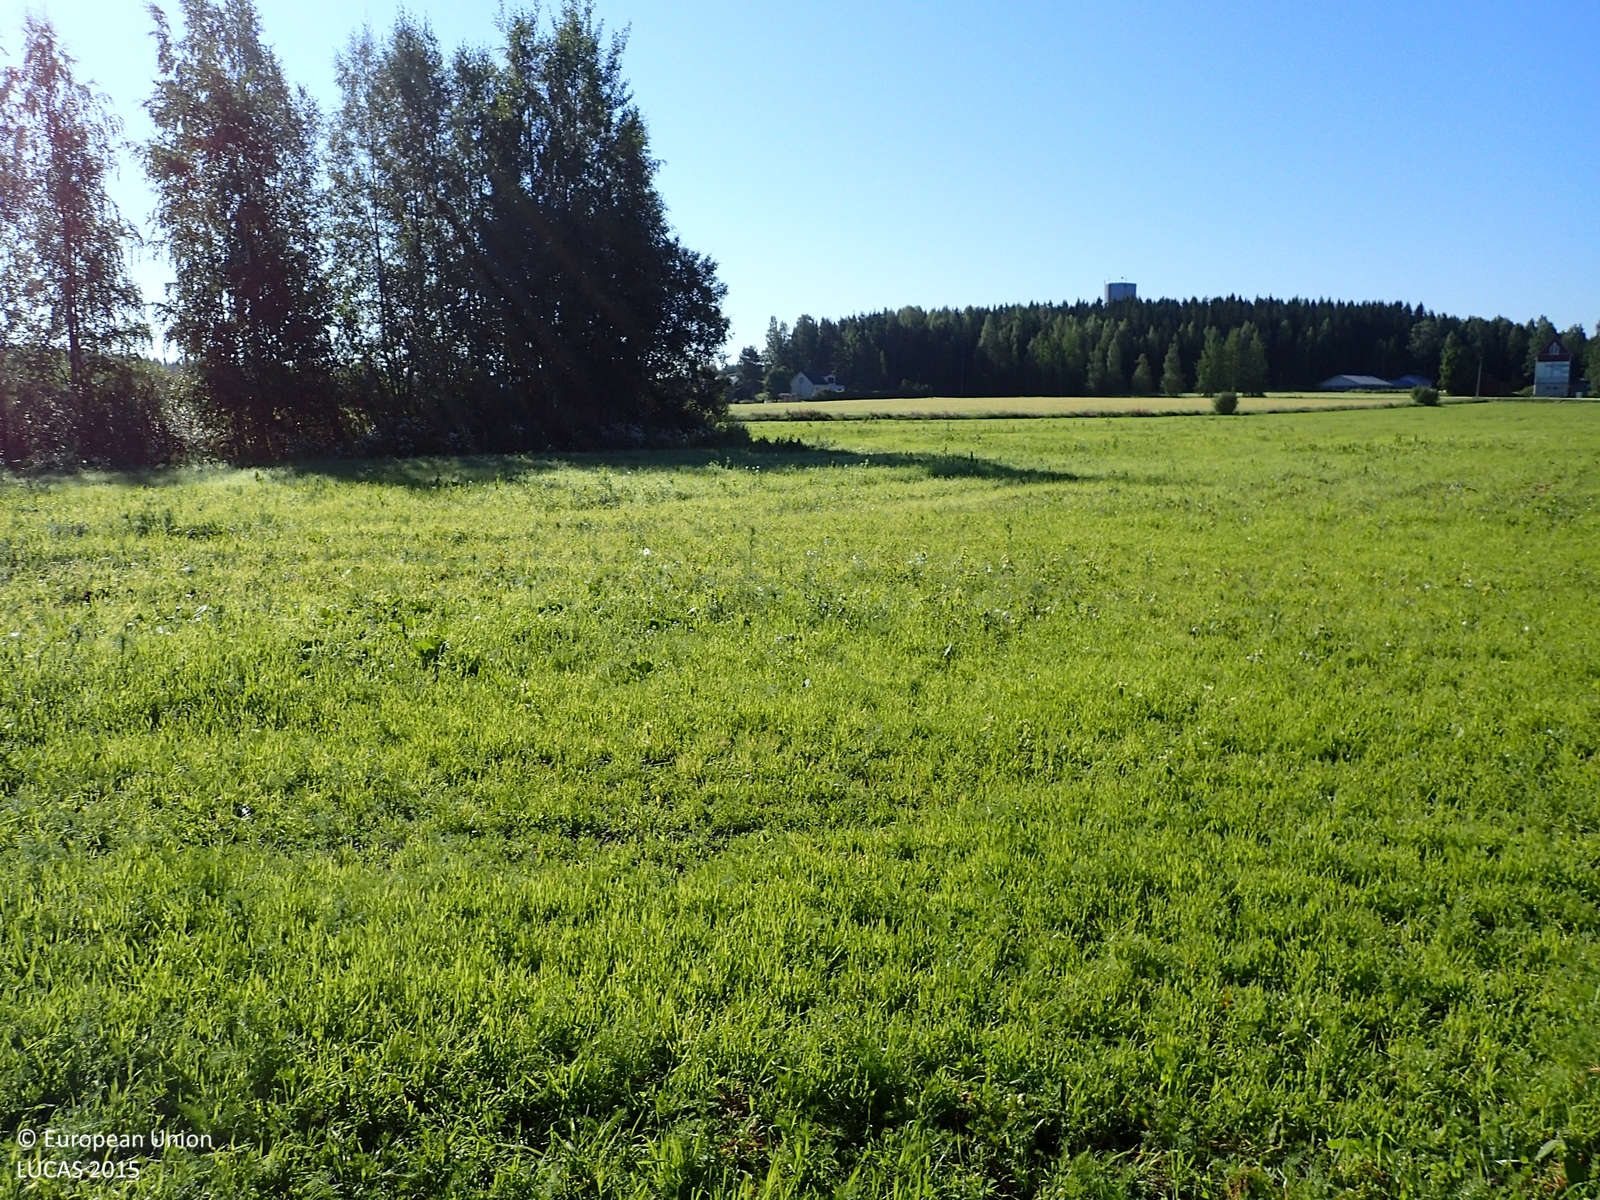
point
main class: Cropland
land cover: Temporary grasslands
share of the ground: > 75 %
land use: Agriculture (excluding fallow land and kitchen gardens)
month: August
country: FI
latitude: 62.5080
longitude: 22.7388
